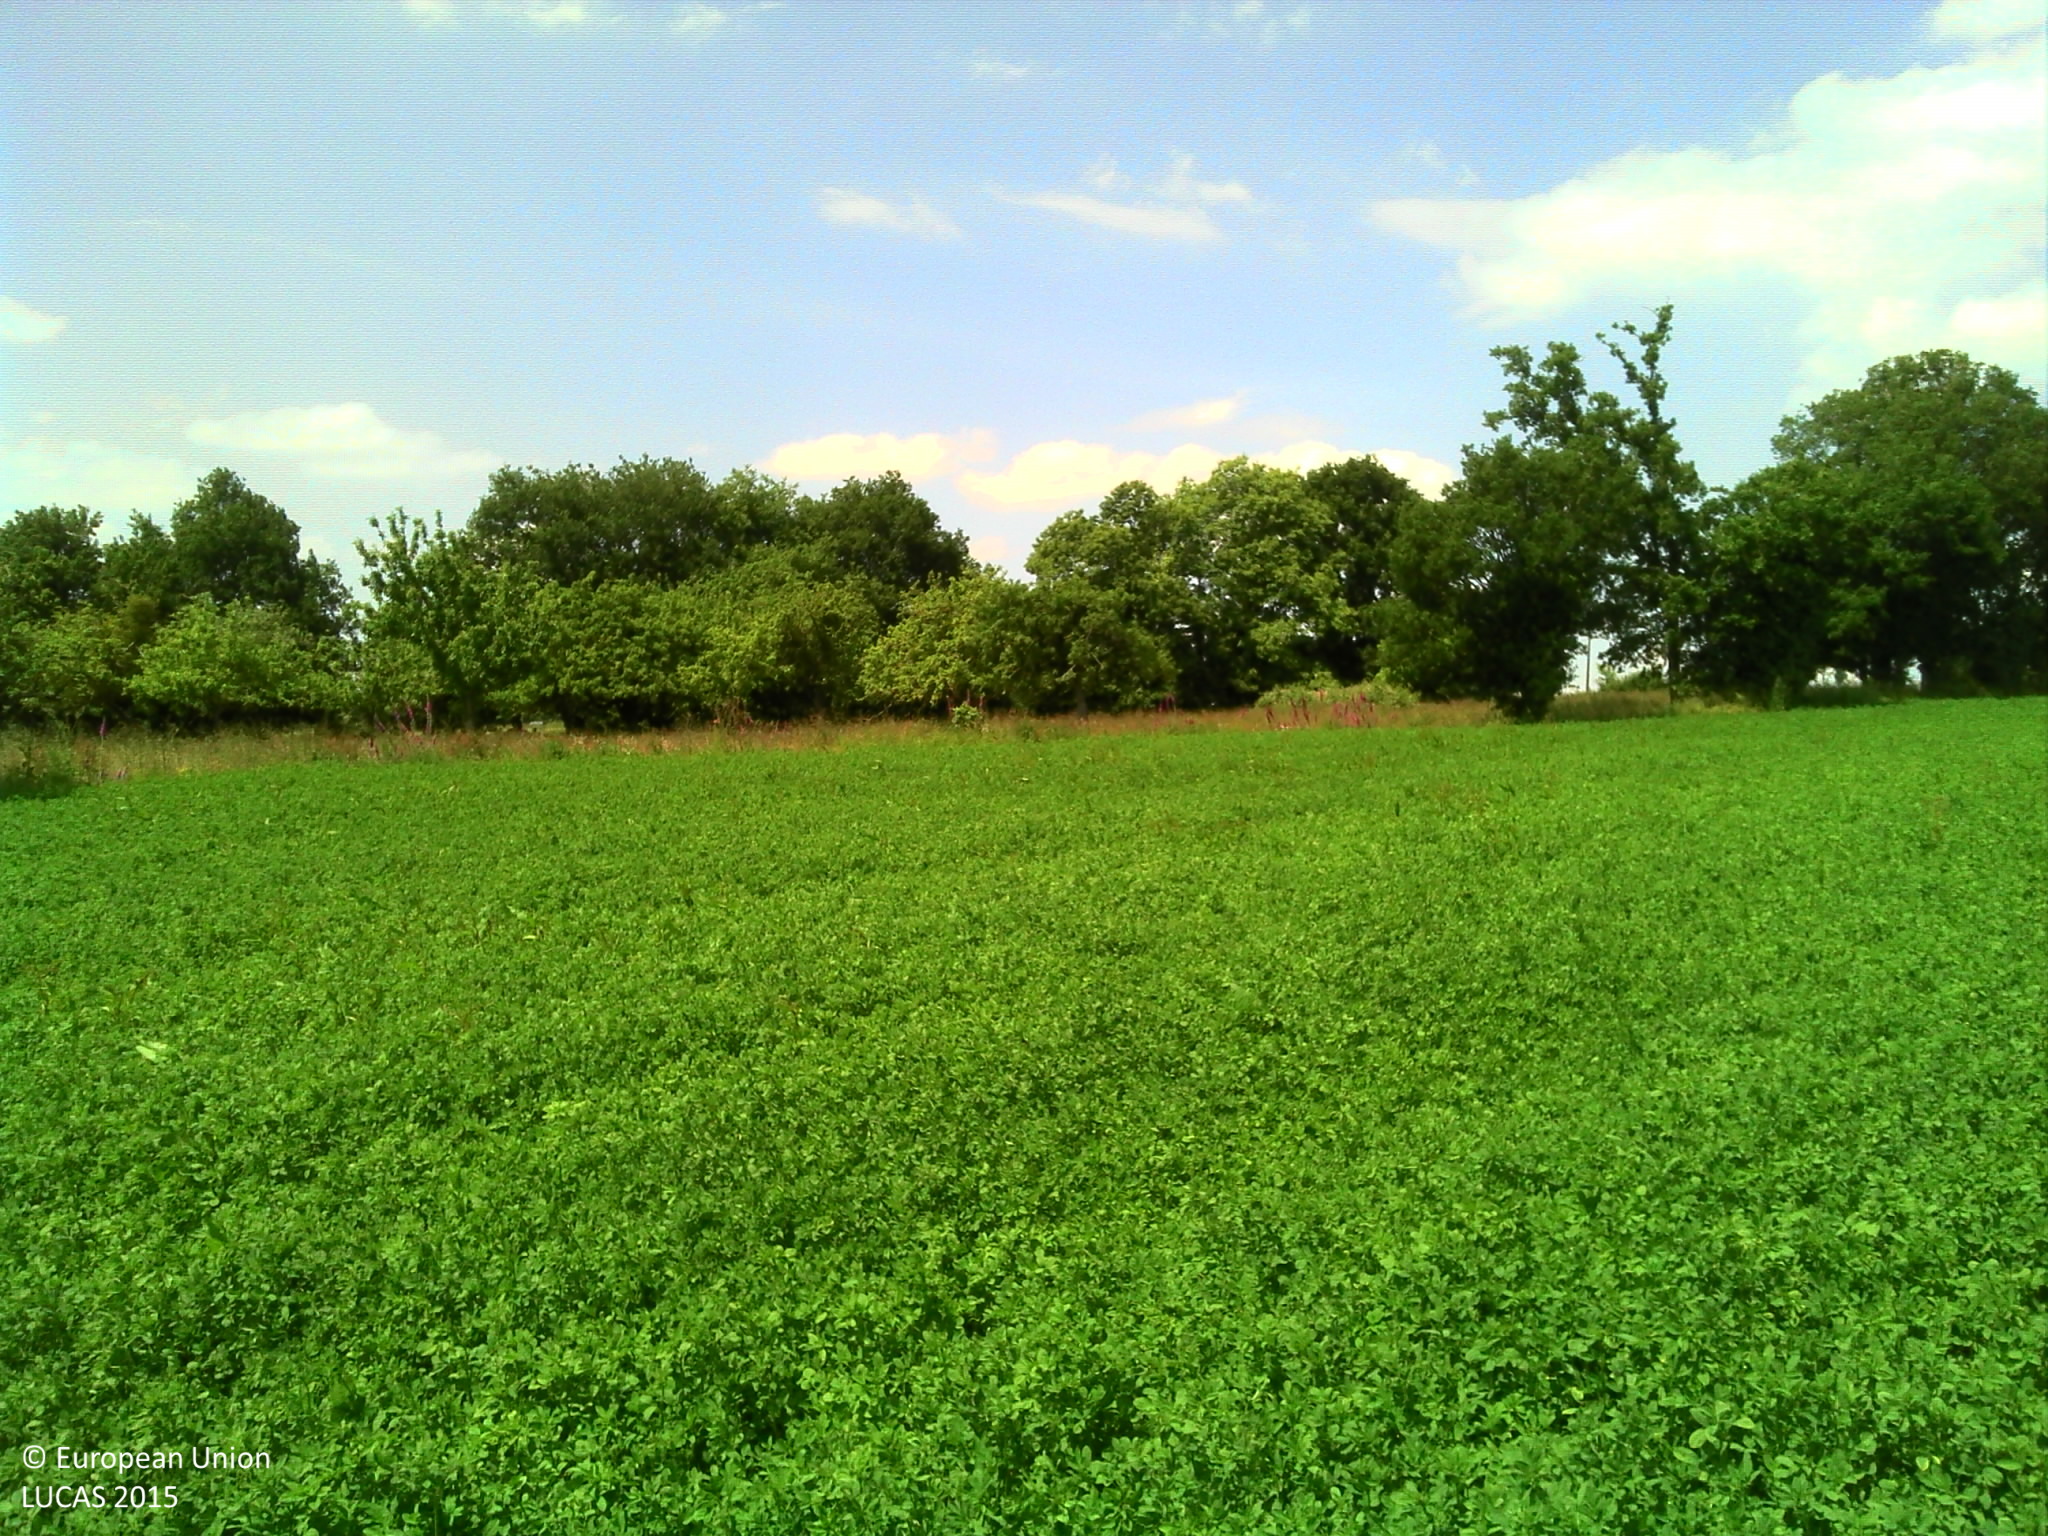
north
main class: Cropland
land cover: Lucerne
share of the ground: > 75 %
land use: Agriculture (excluding fallow land and kitchen gardens)
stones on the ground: < 10 %
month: June
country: FR
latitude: 48.1840
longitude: -1.1378
